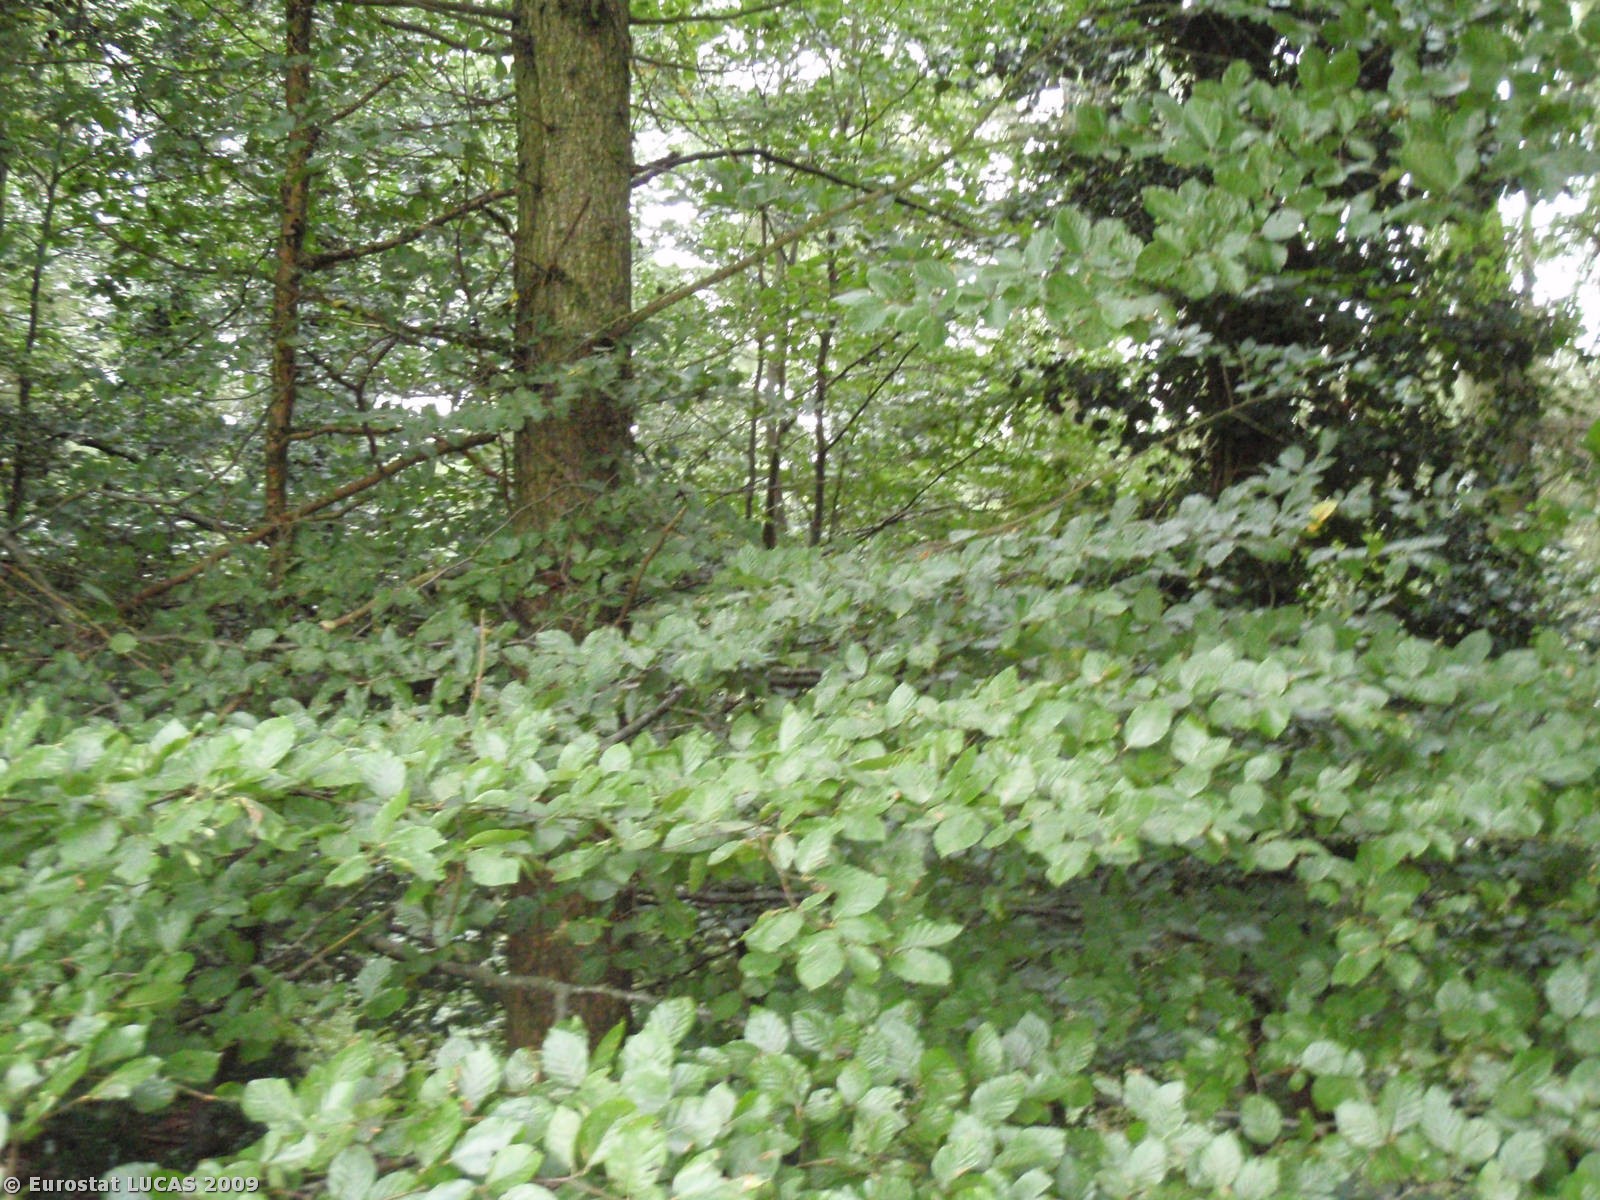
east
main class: Grassland
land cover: Grassland without tree/shrub cover
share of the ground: > 75 %
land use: Agriculture (excluding fallow land and kitchen gardens)
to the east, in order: Grassland without tree/shrub cover; Fences; Coniferous woodland; Tracks; Coniferous woodland; Tracks; Coniferous woodland; Broadleaved woodland; Fences; Broadleaved woodland; Grassland without tree/shrub cover
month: September
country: GB
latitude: 51.0744
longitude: -3.4859
